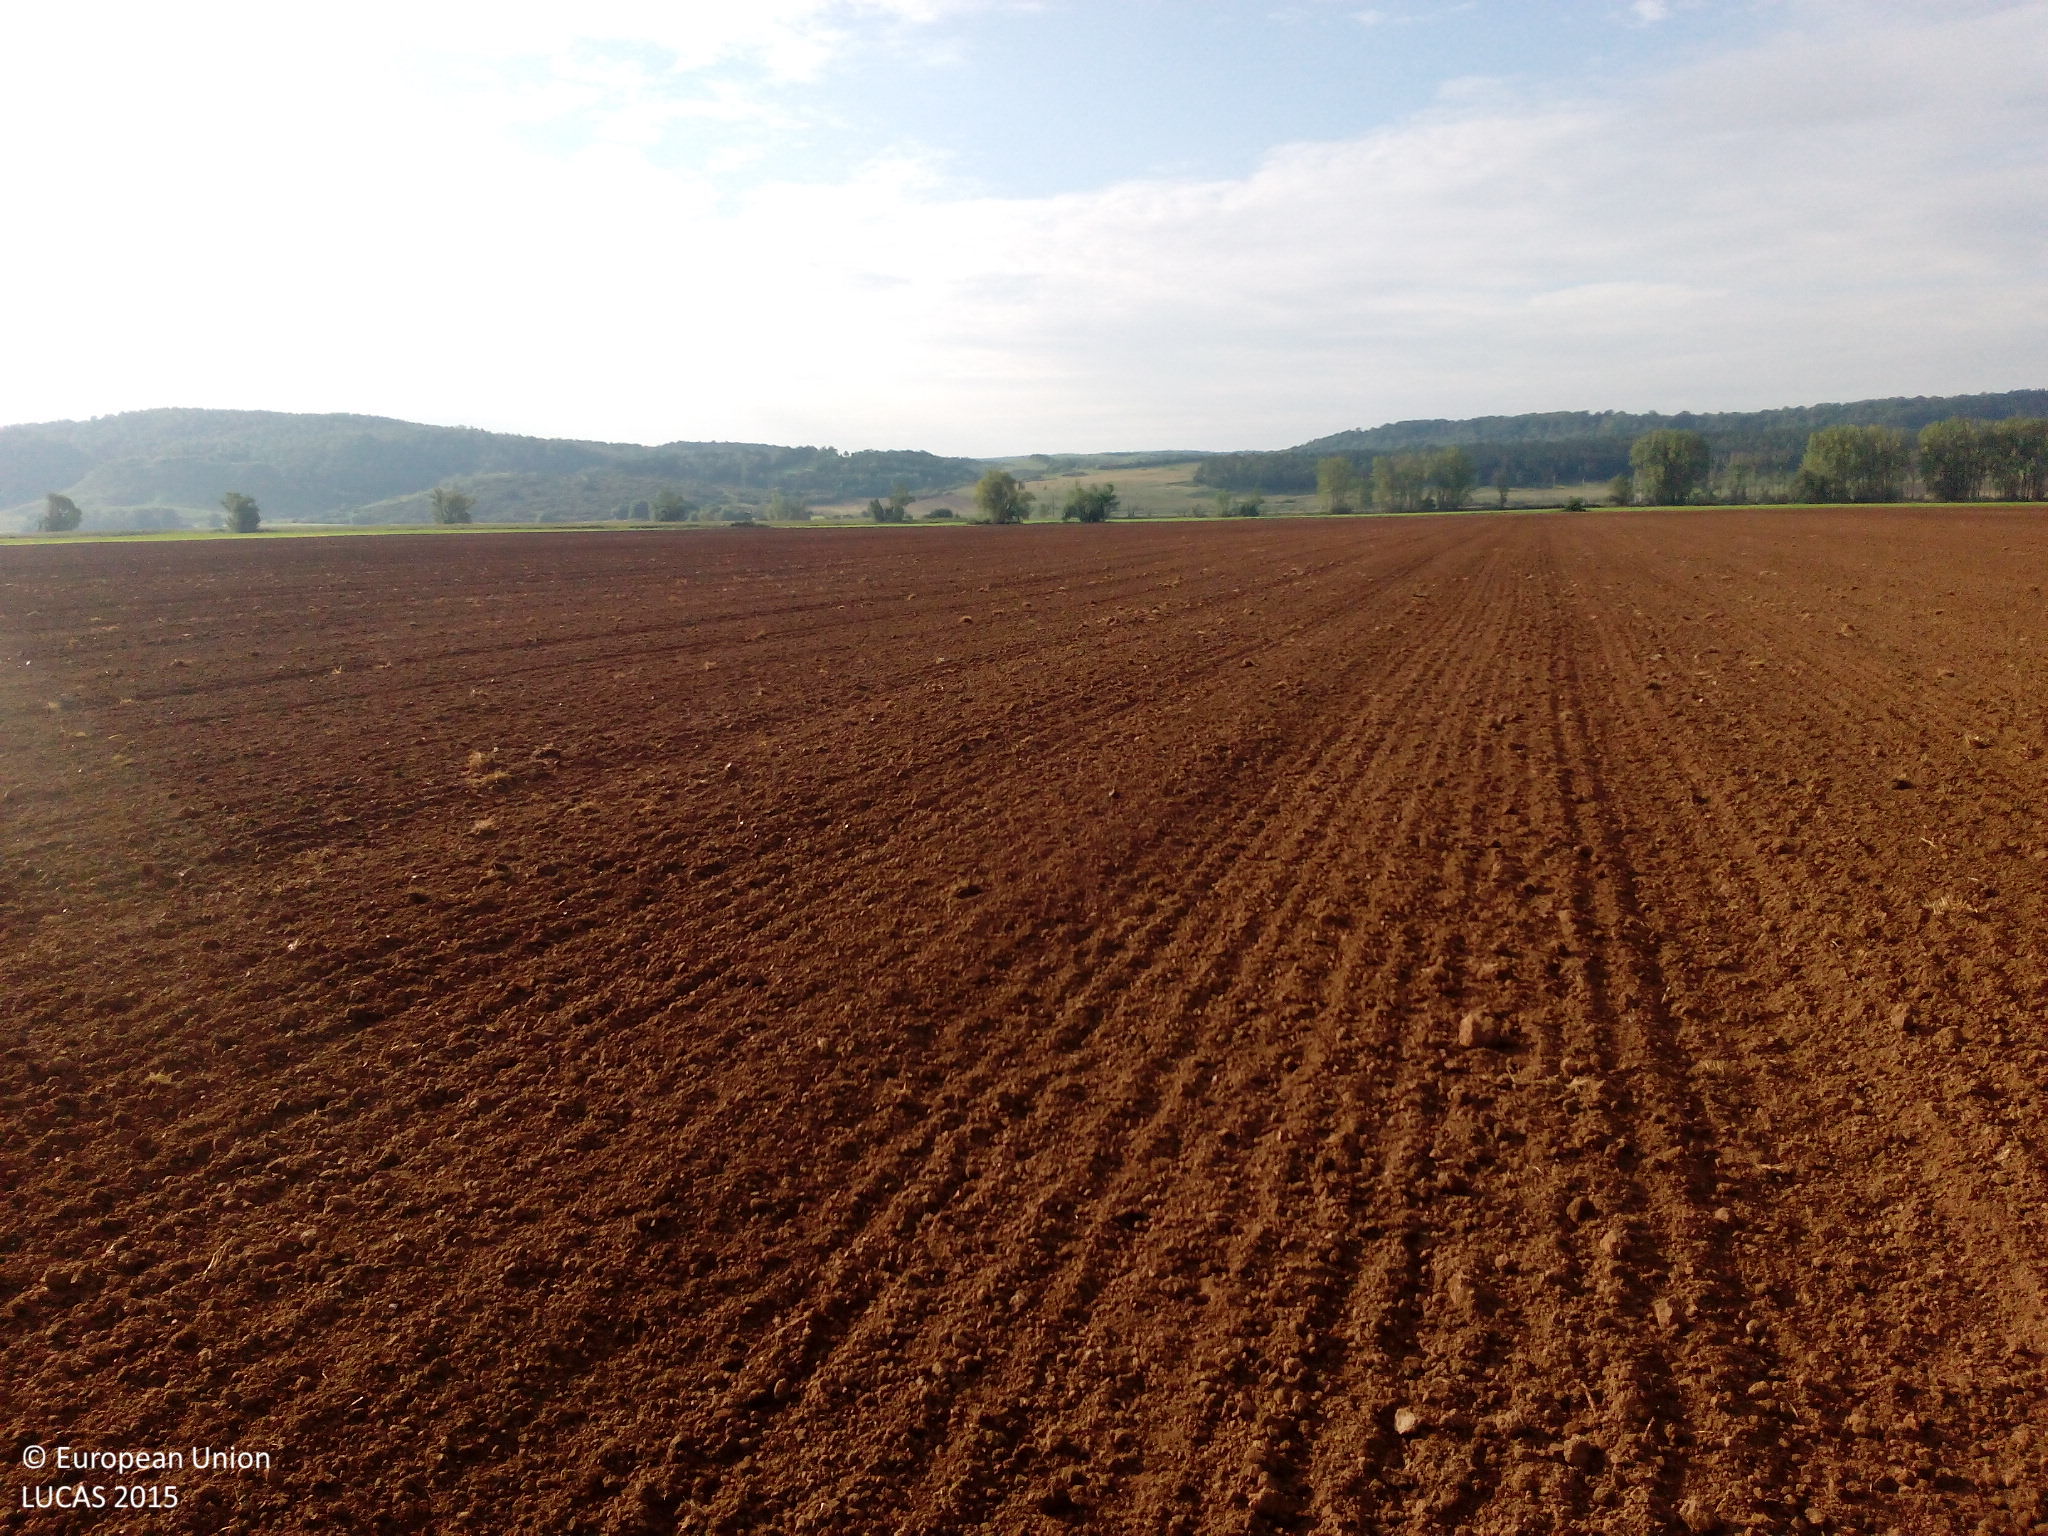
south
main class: Cropland
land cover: Barley
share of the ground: < 10 %
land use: Agriculture (excluding fallow land and kitchen gardens)
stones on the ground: < 10 %
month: September
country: DE
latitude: 51.4388
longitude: 10.9636
